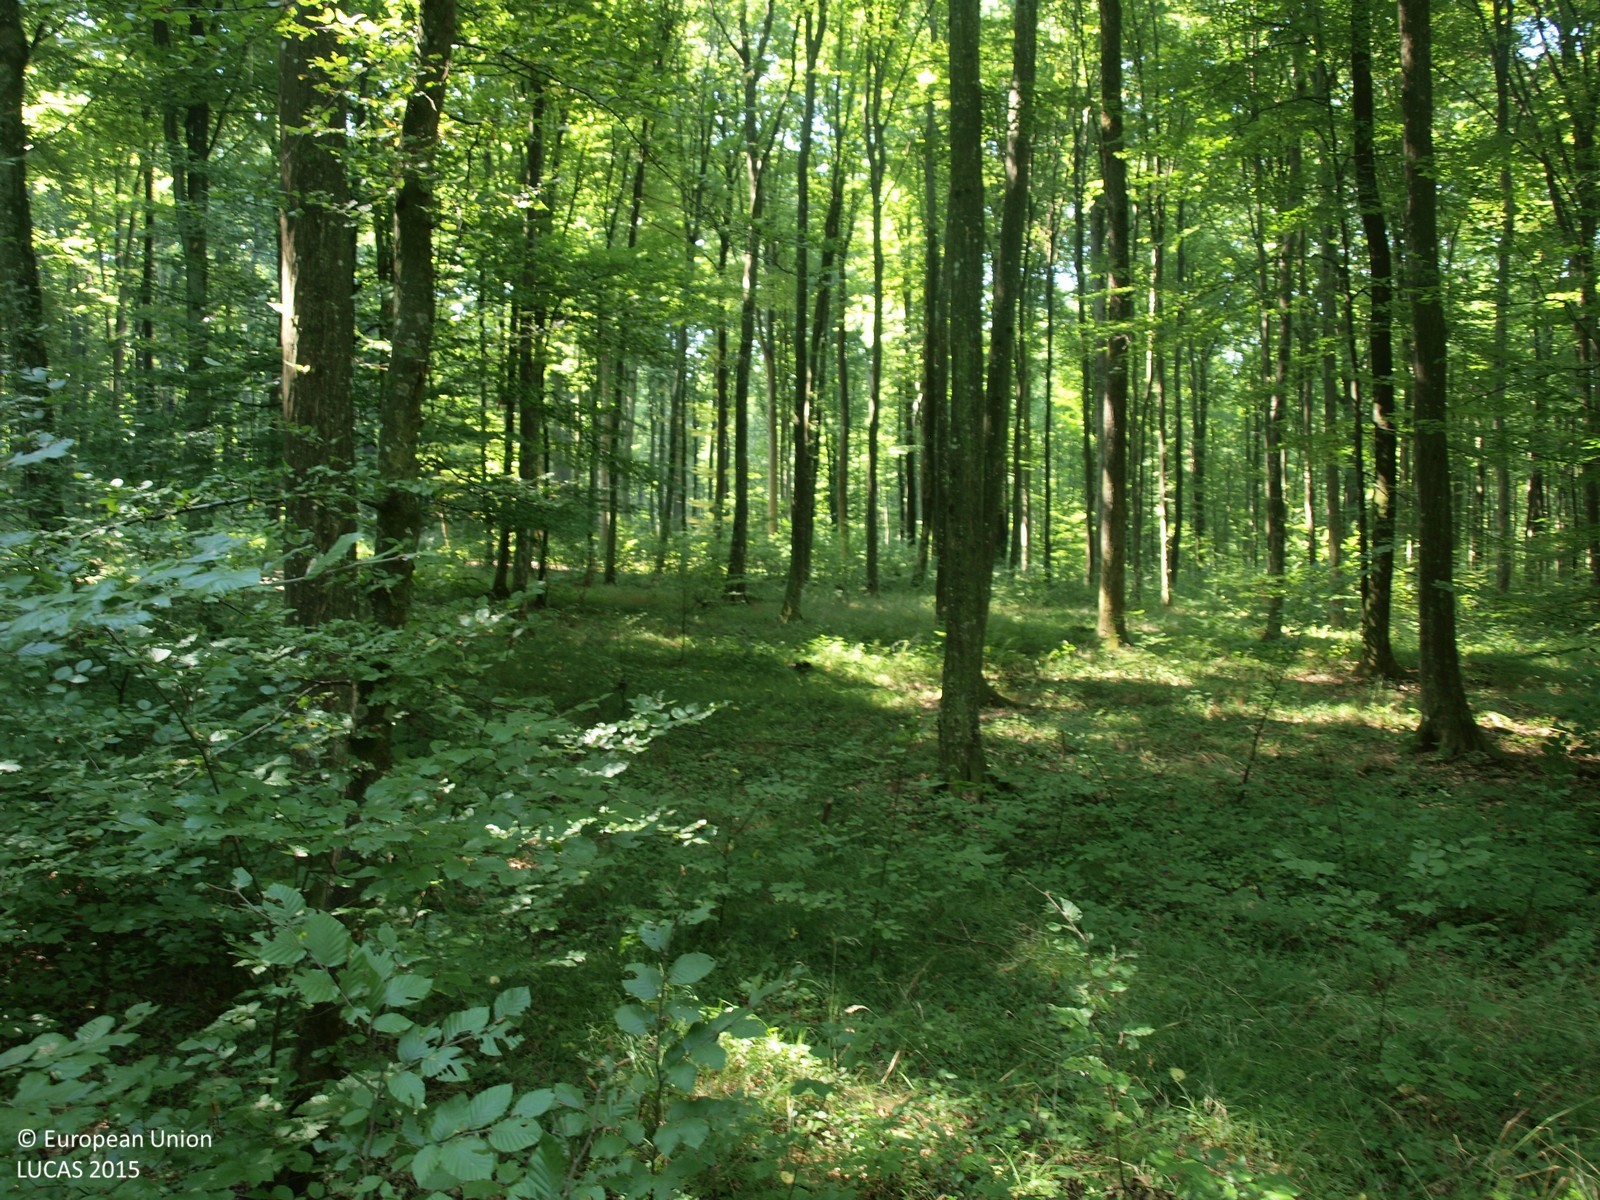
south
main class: Woodland
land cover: Broadleaved woodland
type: mesophytic deciduous forest
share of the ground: > 75 %
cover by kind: broadleaved forest trees 100 %
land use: Forestry
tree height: > 5 m
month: August
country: HR
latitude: 45.9327
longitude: 16.5642
